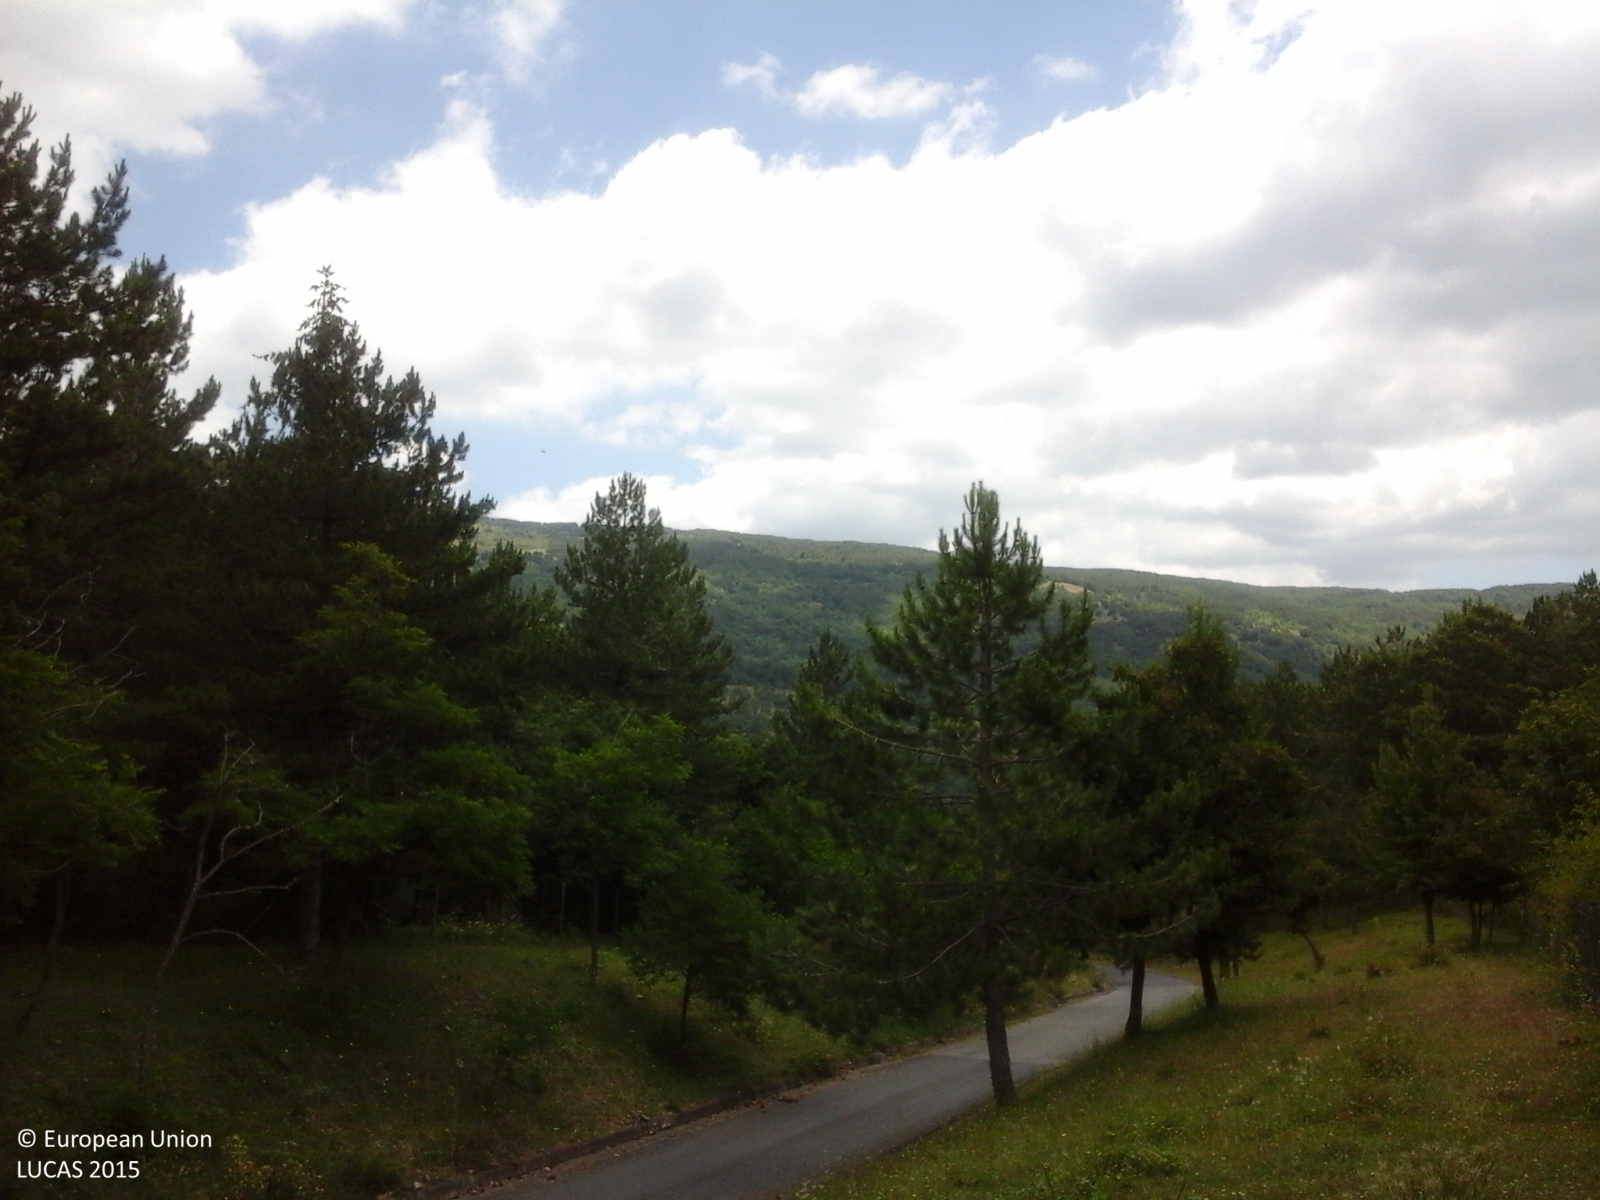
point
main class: Woodland
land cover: Broadleaved woodland
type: thermophilous deciduous forest
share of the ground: > 75 %
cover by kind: broadleaved forest trees 75 %, shrubs 15 %, herbaceous plants 10 %
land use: Amenities, museums, leisure
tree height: > 5 m
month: July
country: IT
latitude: 37.9329
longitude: 14.8481
